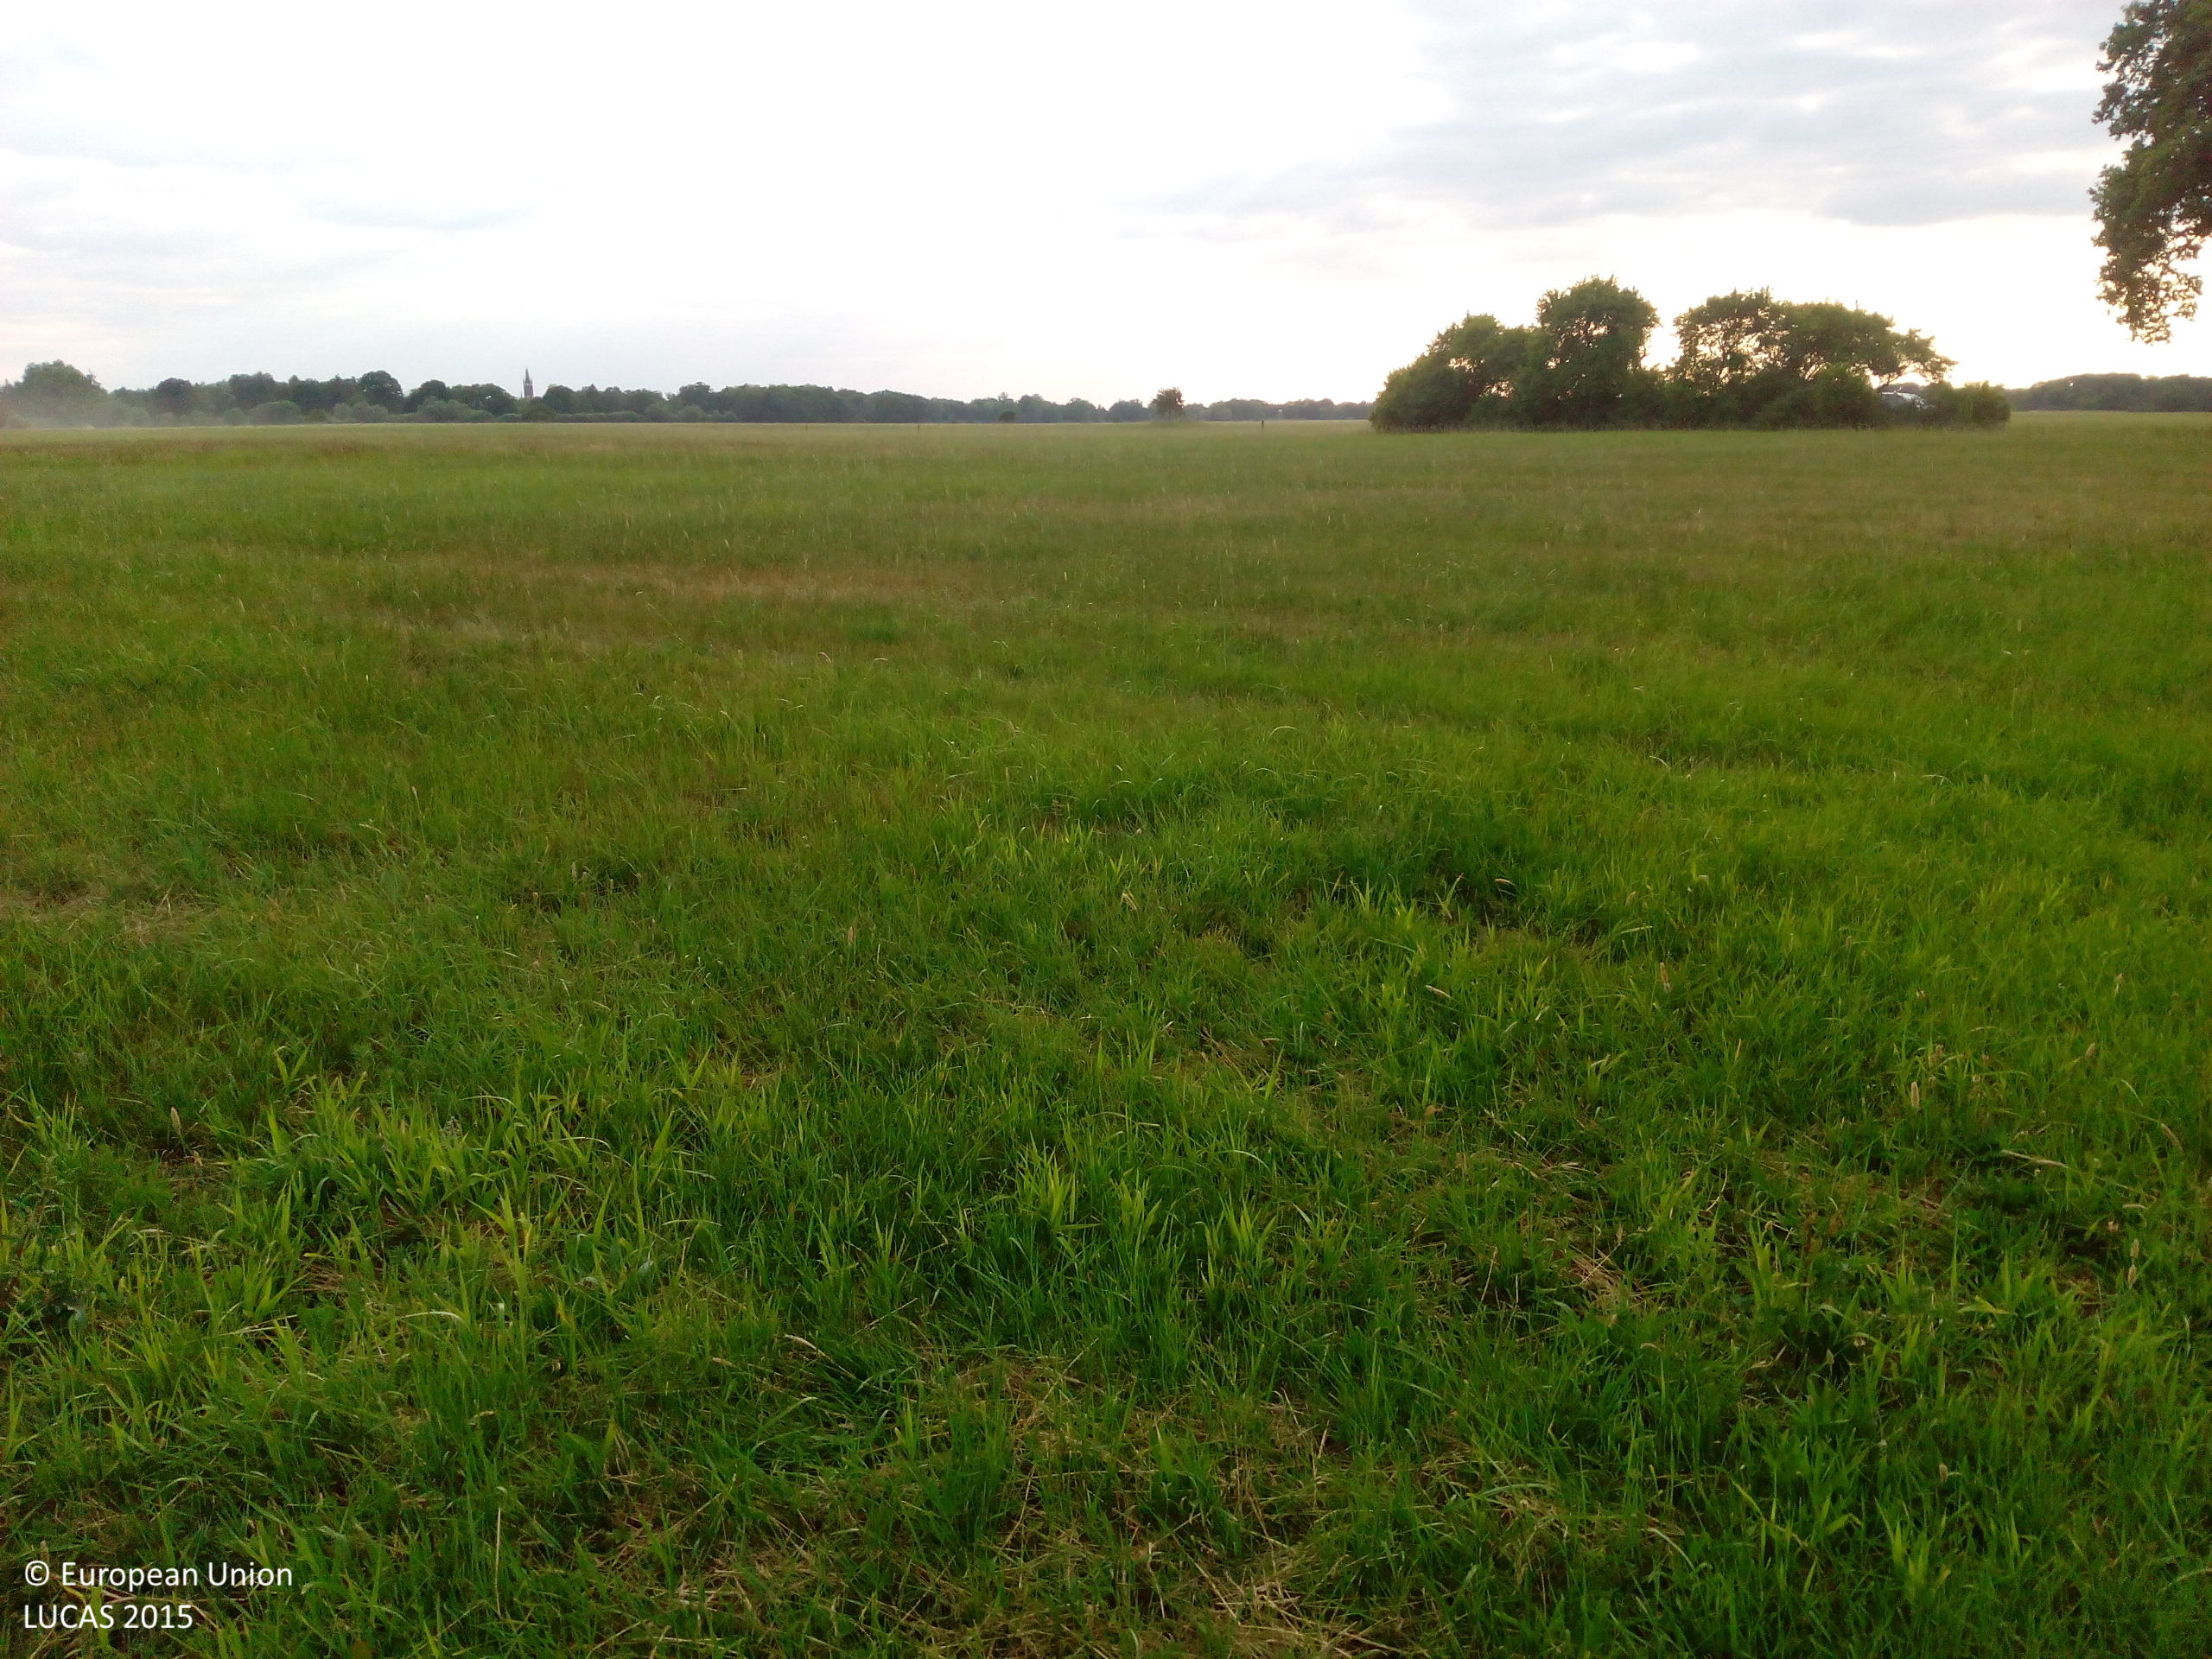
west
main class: Grassland
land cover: Grassland without tree/shrub cover
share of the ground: > 75 %
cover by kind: herbaceous plants 100 %
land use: Agriculture (excluding fallow land and kitchen gardens)
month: June
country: DE
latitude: 51.8486
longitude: 12.4530
